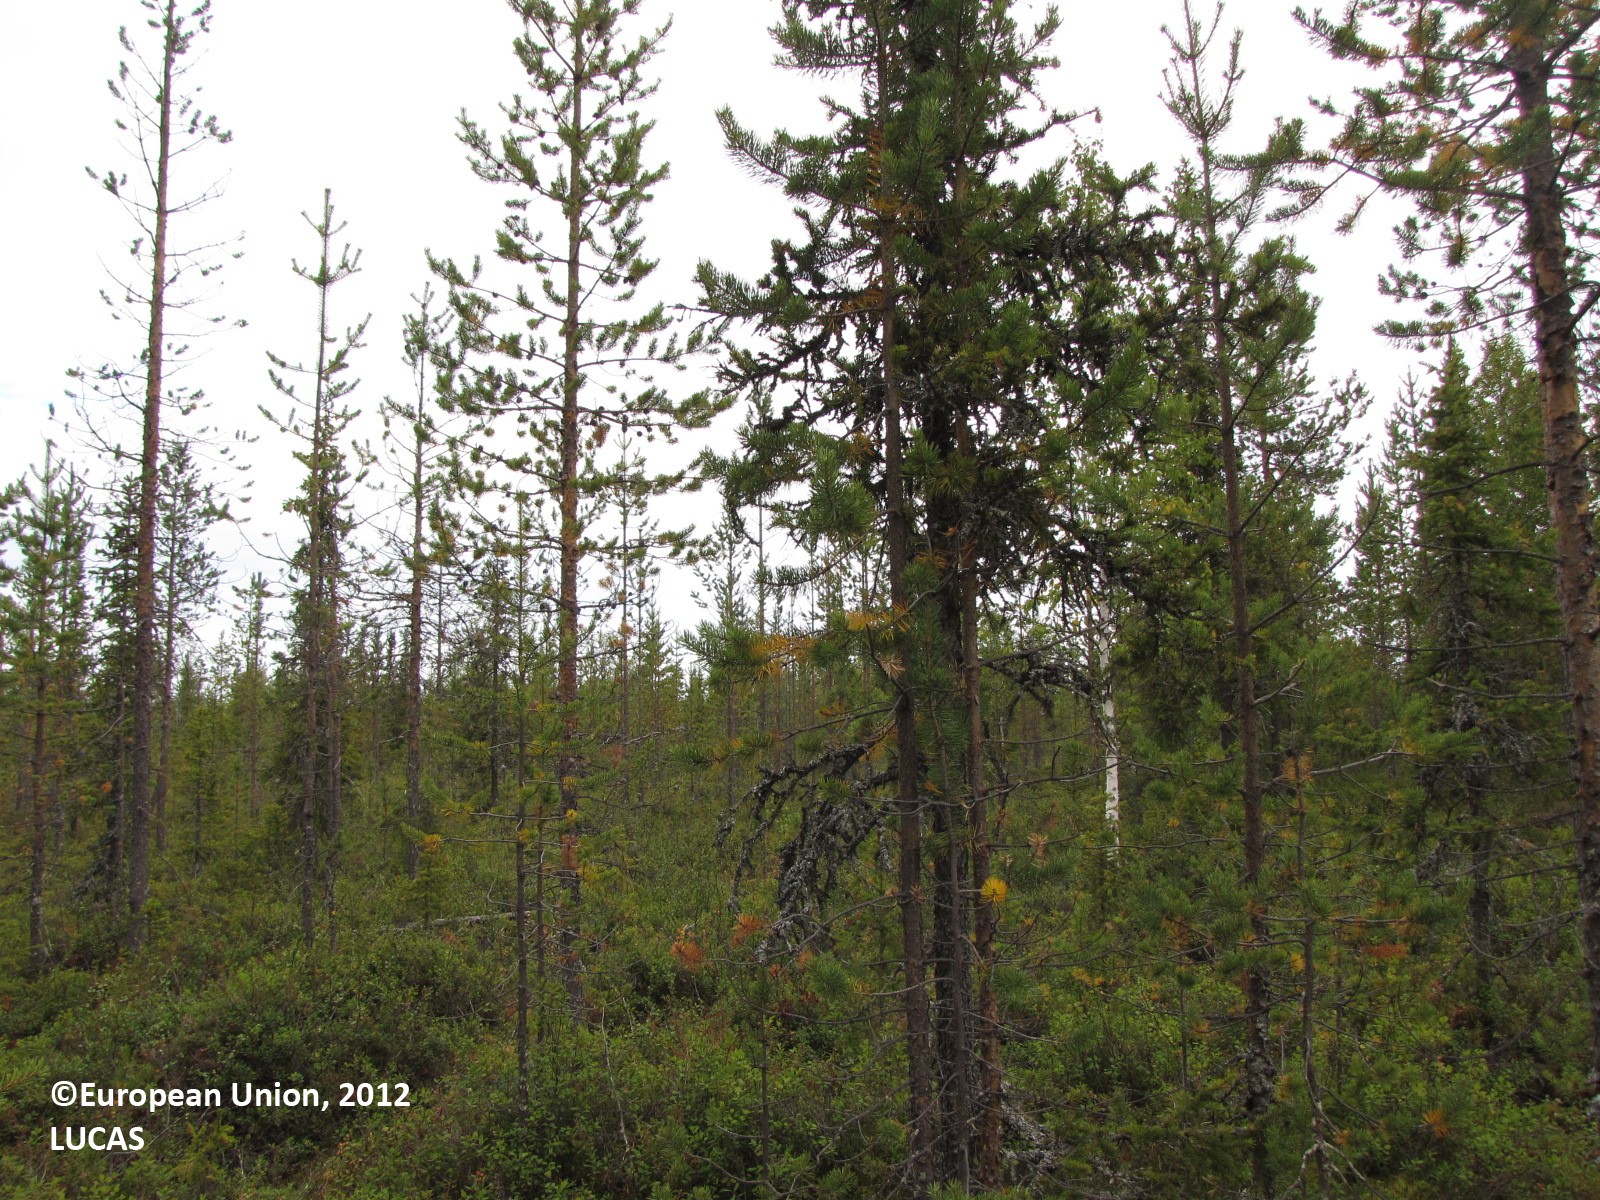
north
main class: Woodland
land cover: Other coniferous woodland
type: boreal forest
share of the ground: 25 - 50 %
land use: Forestry
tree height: > 5 m
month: August
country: FI
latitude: 67.1205
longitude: 25.1917
